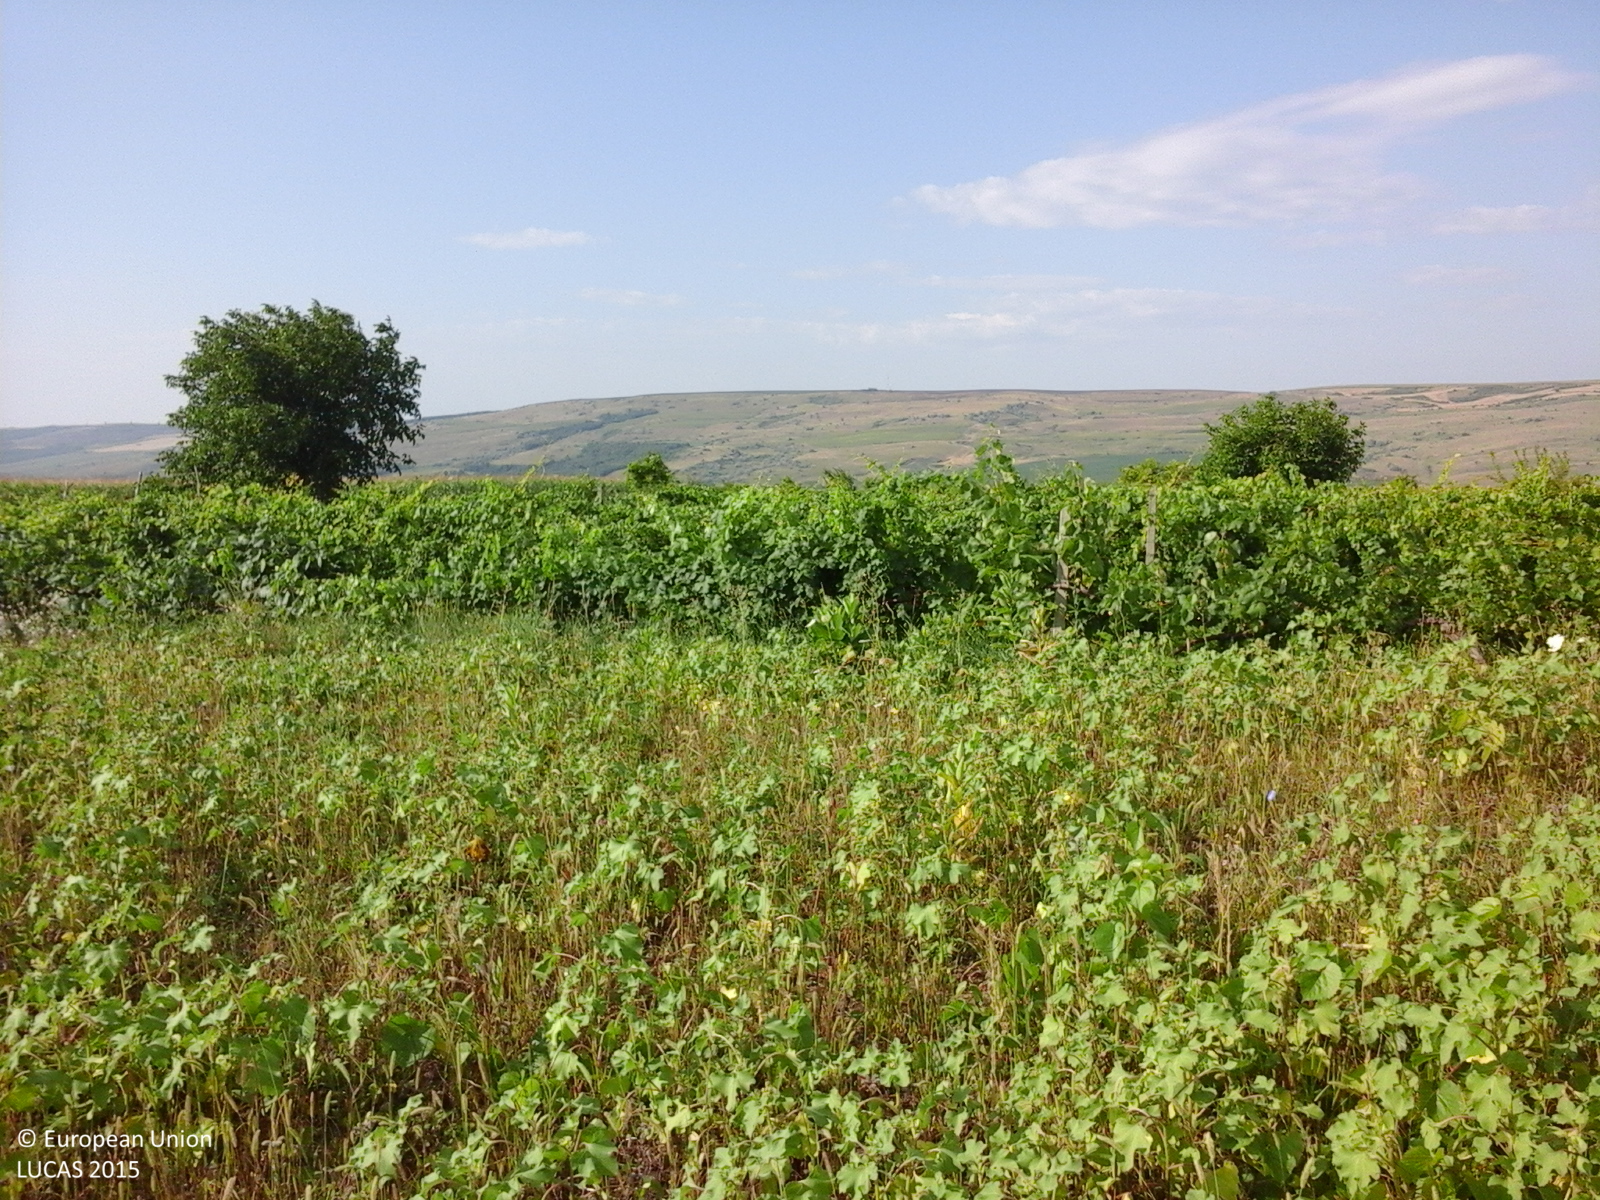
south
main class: Grassland
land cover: Spontaneously vegetated surfaces
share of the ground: > 75 %
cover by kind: herbaceous plants 100 %
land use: Abandoned areas
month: July
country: RO
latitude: 46.1521
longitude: 27.6839
